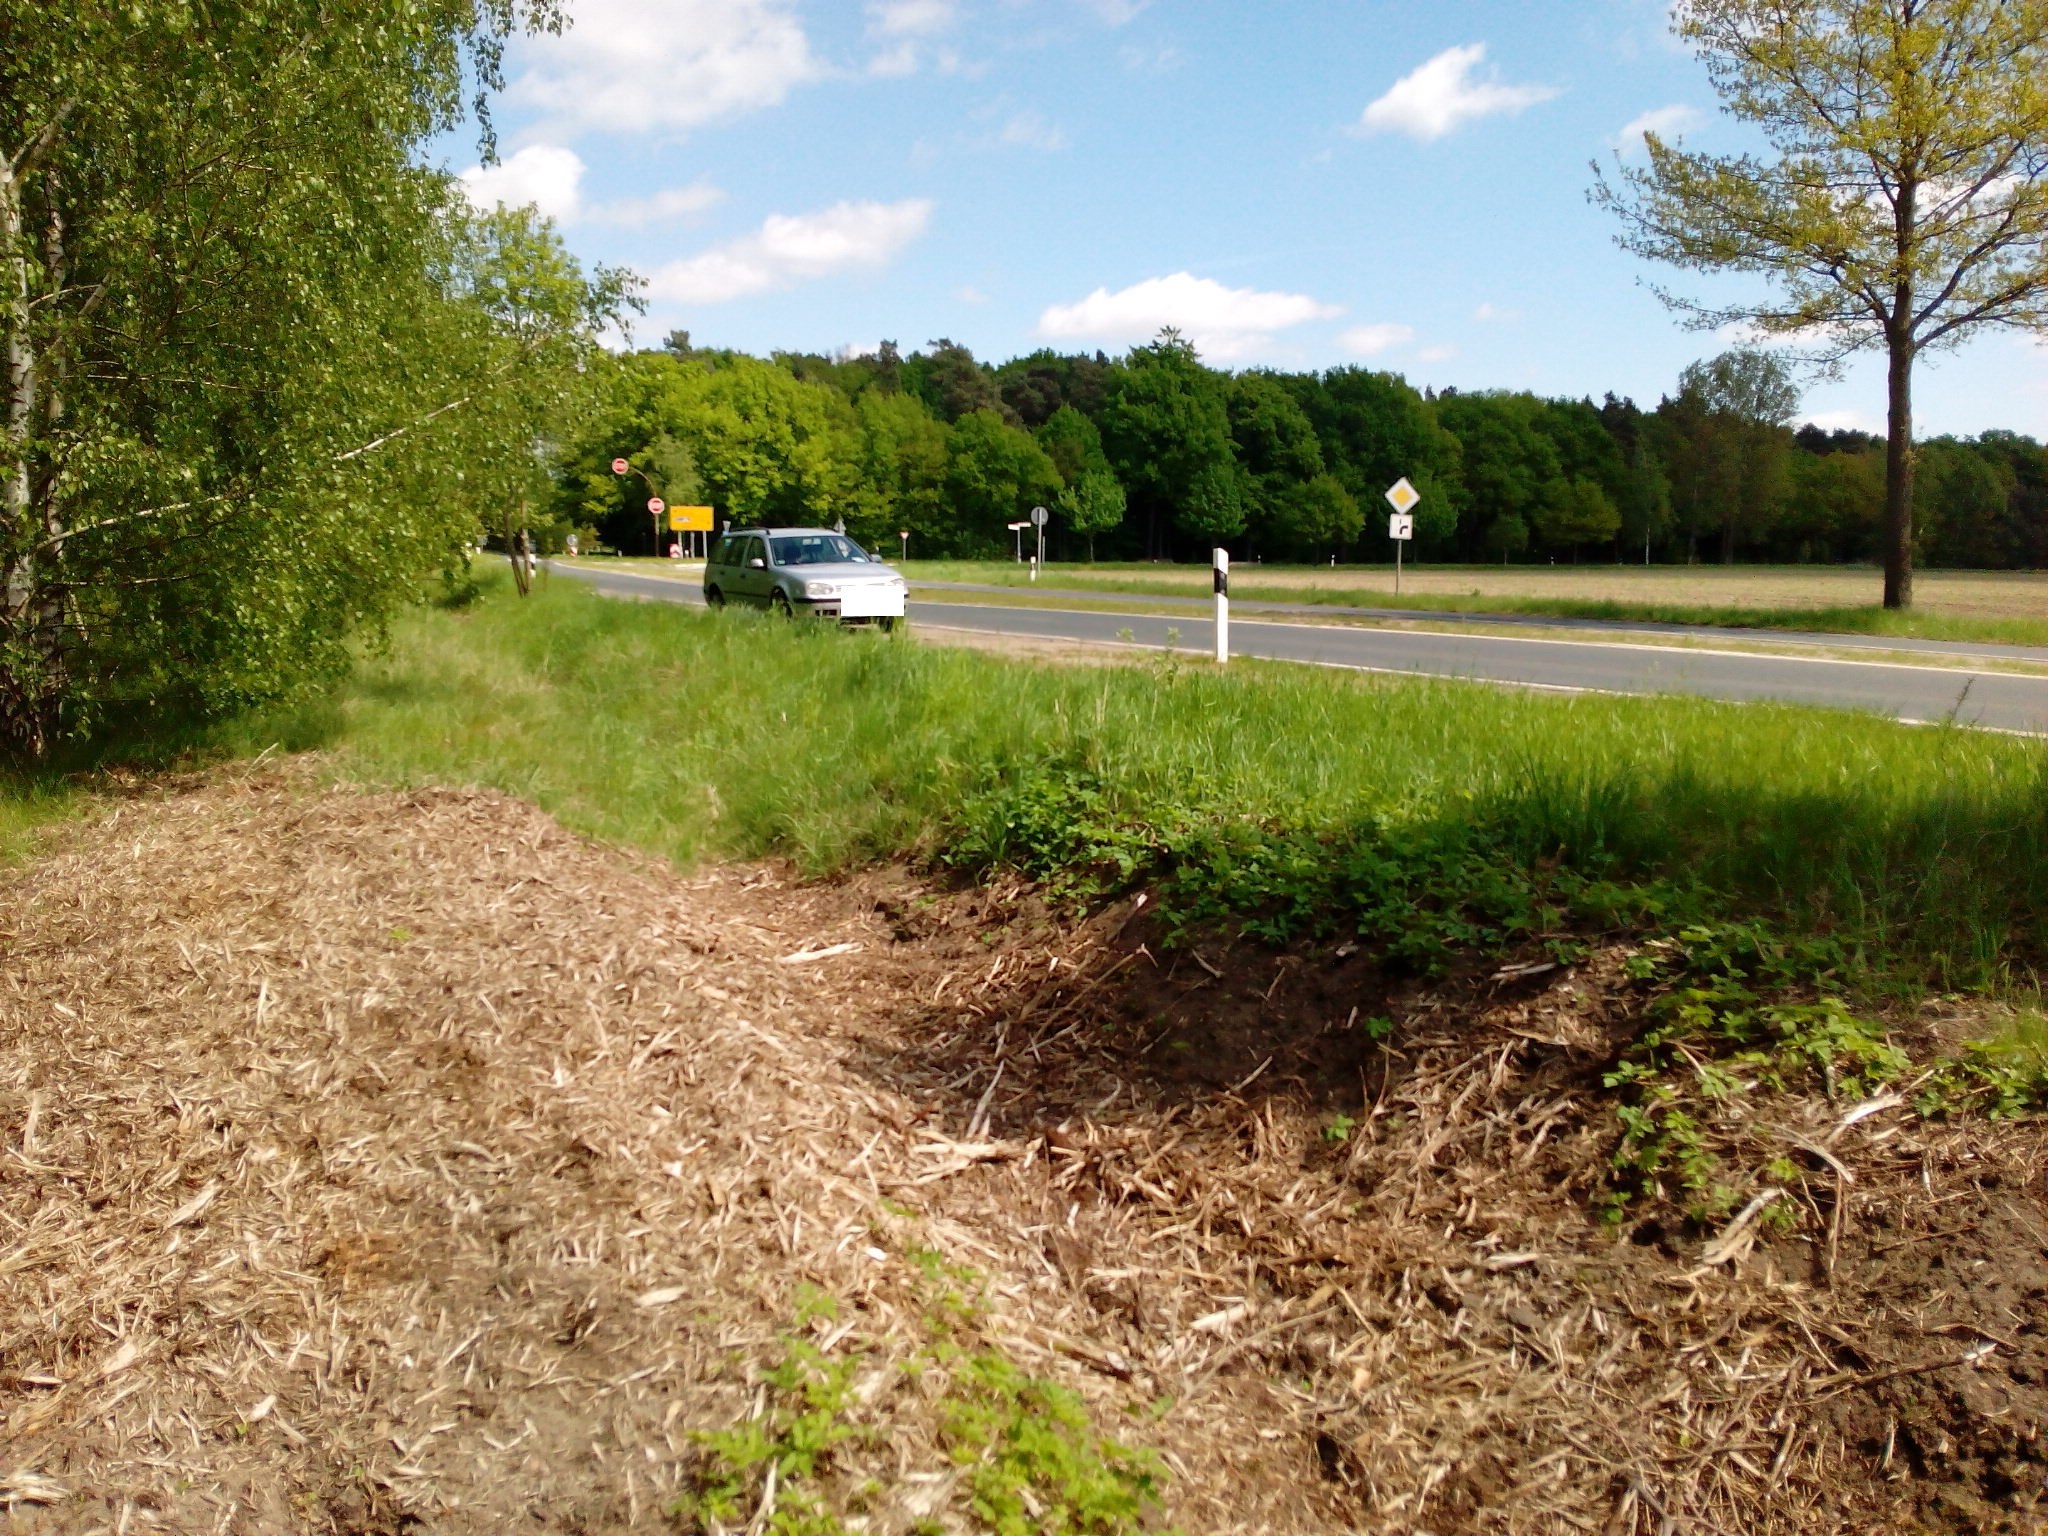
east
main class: Woodland
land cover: Broadleaved woodland
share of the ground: 50 - 75 %
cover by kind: broadleaved forest trees 70 %, herbaceous plants 15 %, consolidated bare surface 15 %
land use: Road transport
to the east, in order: Broadleaved woodland; Ditches and canals; Grass margins; Paved roads, cycling and walking lanes; Grass margins; Tracks; Grass margins; Ditches and canals; Grass margins; Sugar beet; Grass margins; Tracks; Lines of trees; Ditches and canals; Paved roads, cycling and walking lanes; Grass margins; Ditches and canals; Pine dominated mixed woodland
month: May
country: DE
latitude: 52.4493
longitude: 9.9265
